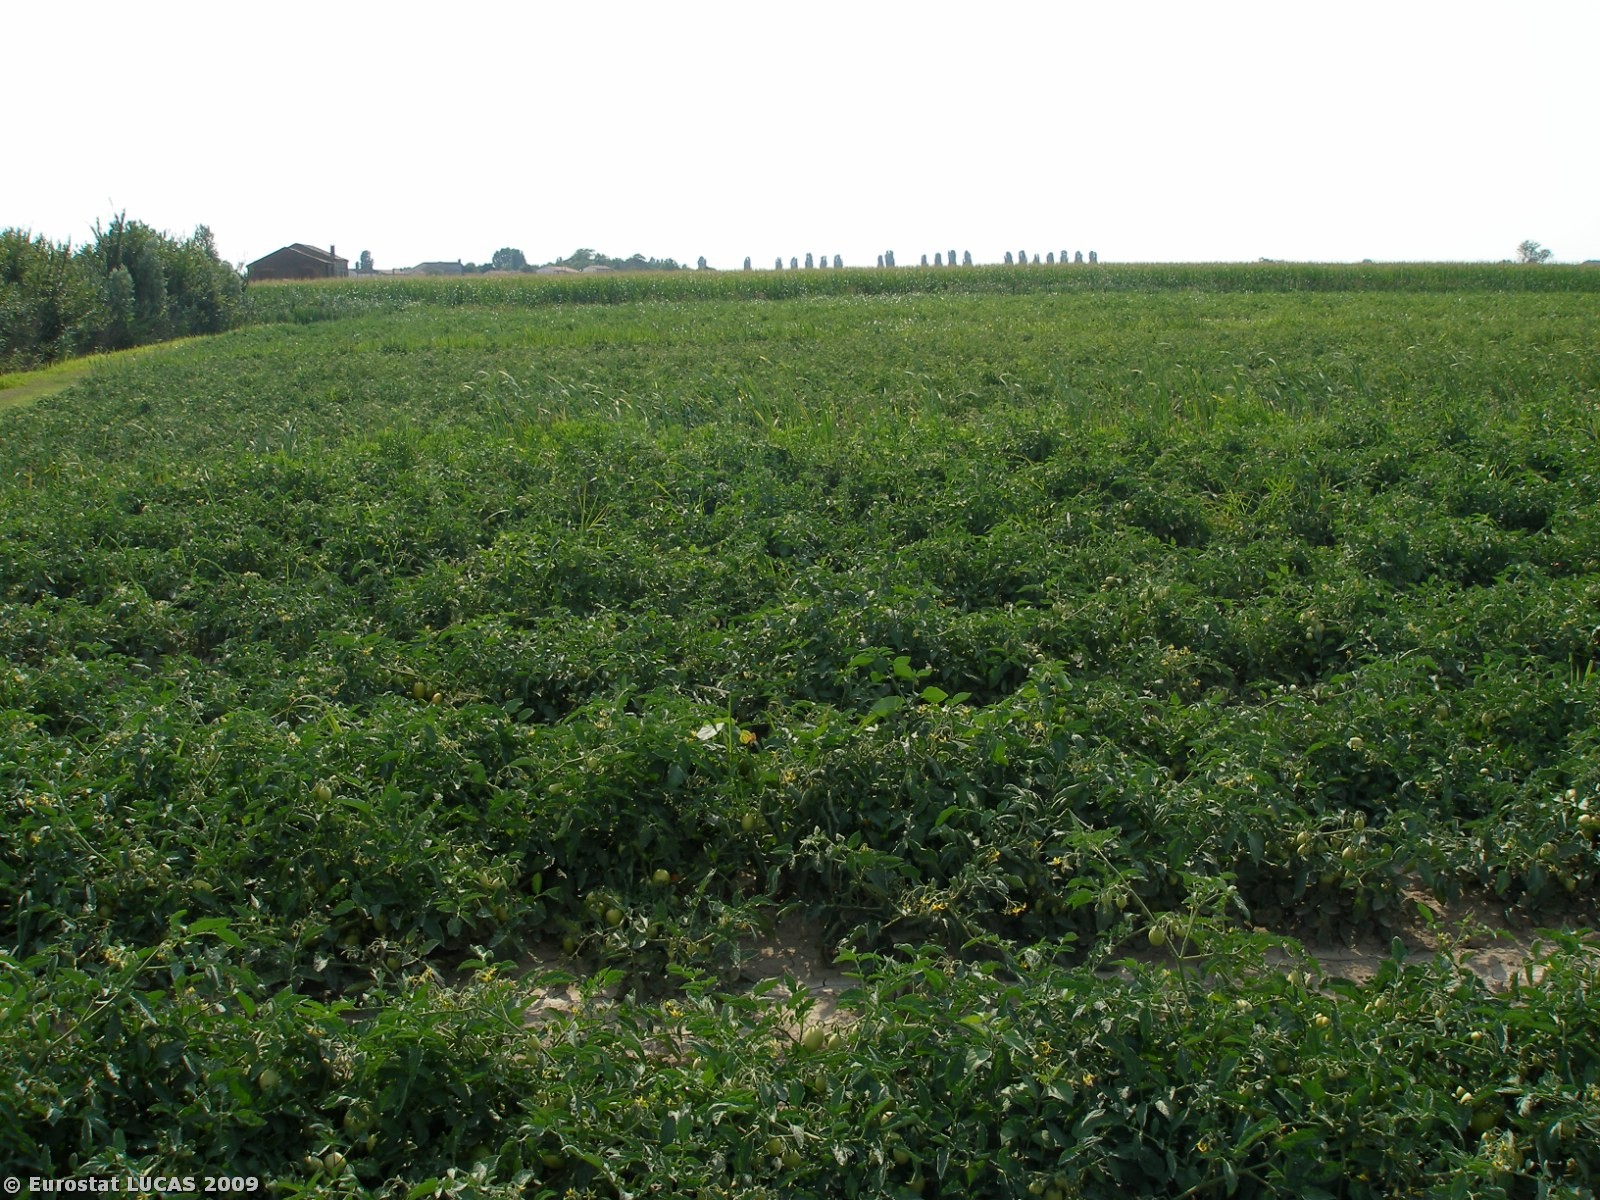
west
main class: Cropland
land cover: Tomatoes
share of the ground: > 75 %
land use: Agriculture (excluding fallow land and kitchen gardens)
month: July
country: IT
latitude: 45.0050
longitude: 11.6335
